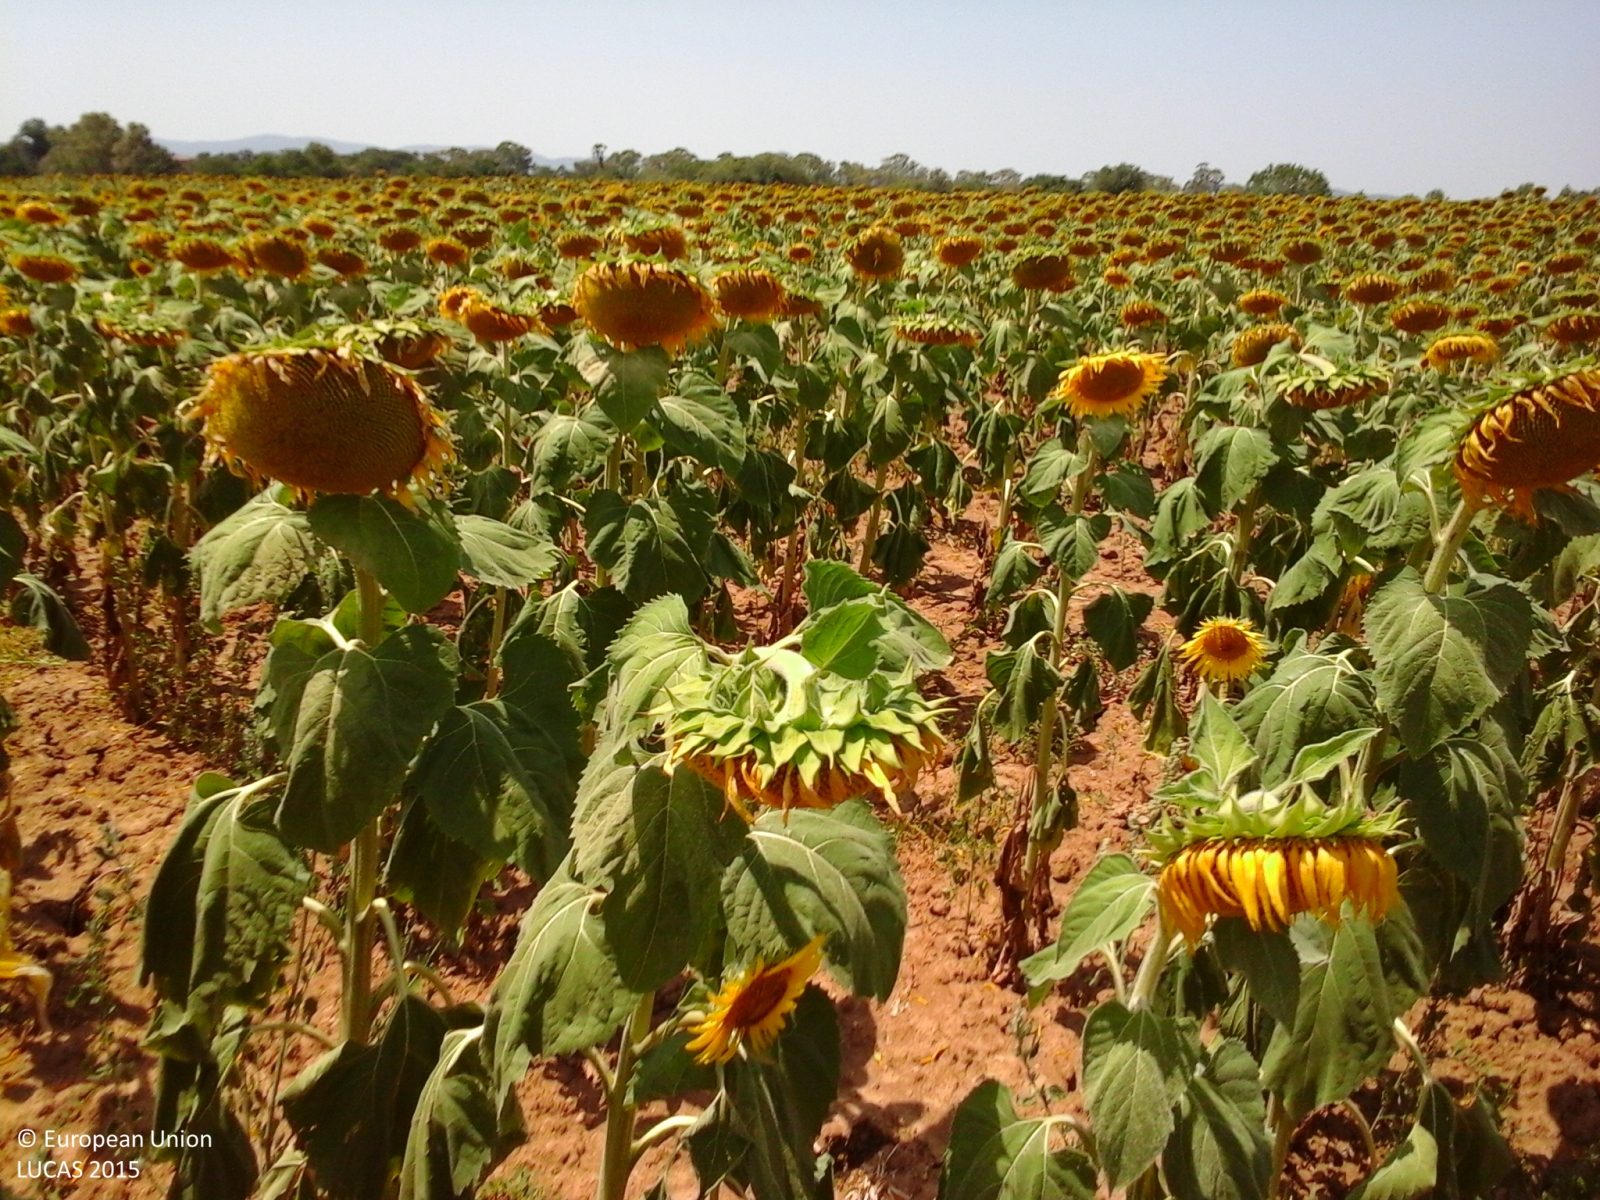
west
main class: Cropland
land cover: Sunflower
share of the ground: > 75 %
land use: Agriculture (excluding fallow land and kitchen gardens)
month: July
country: IT
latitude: 42.9374
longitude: 11.0628
